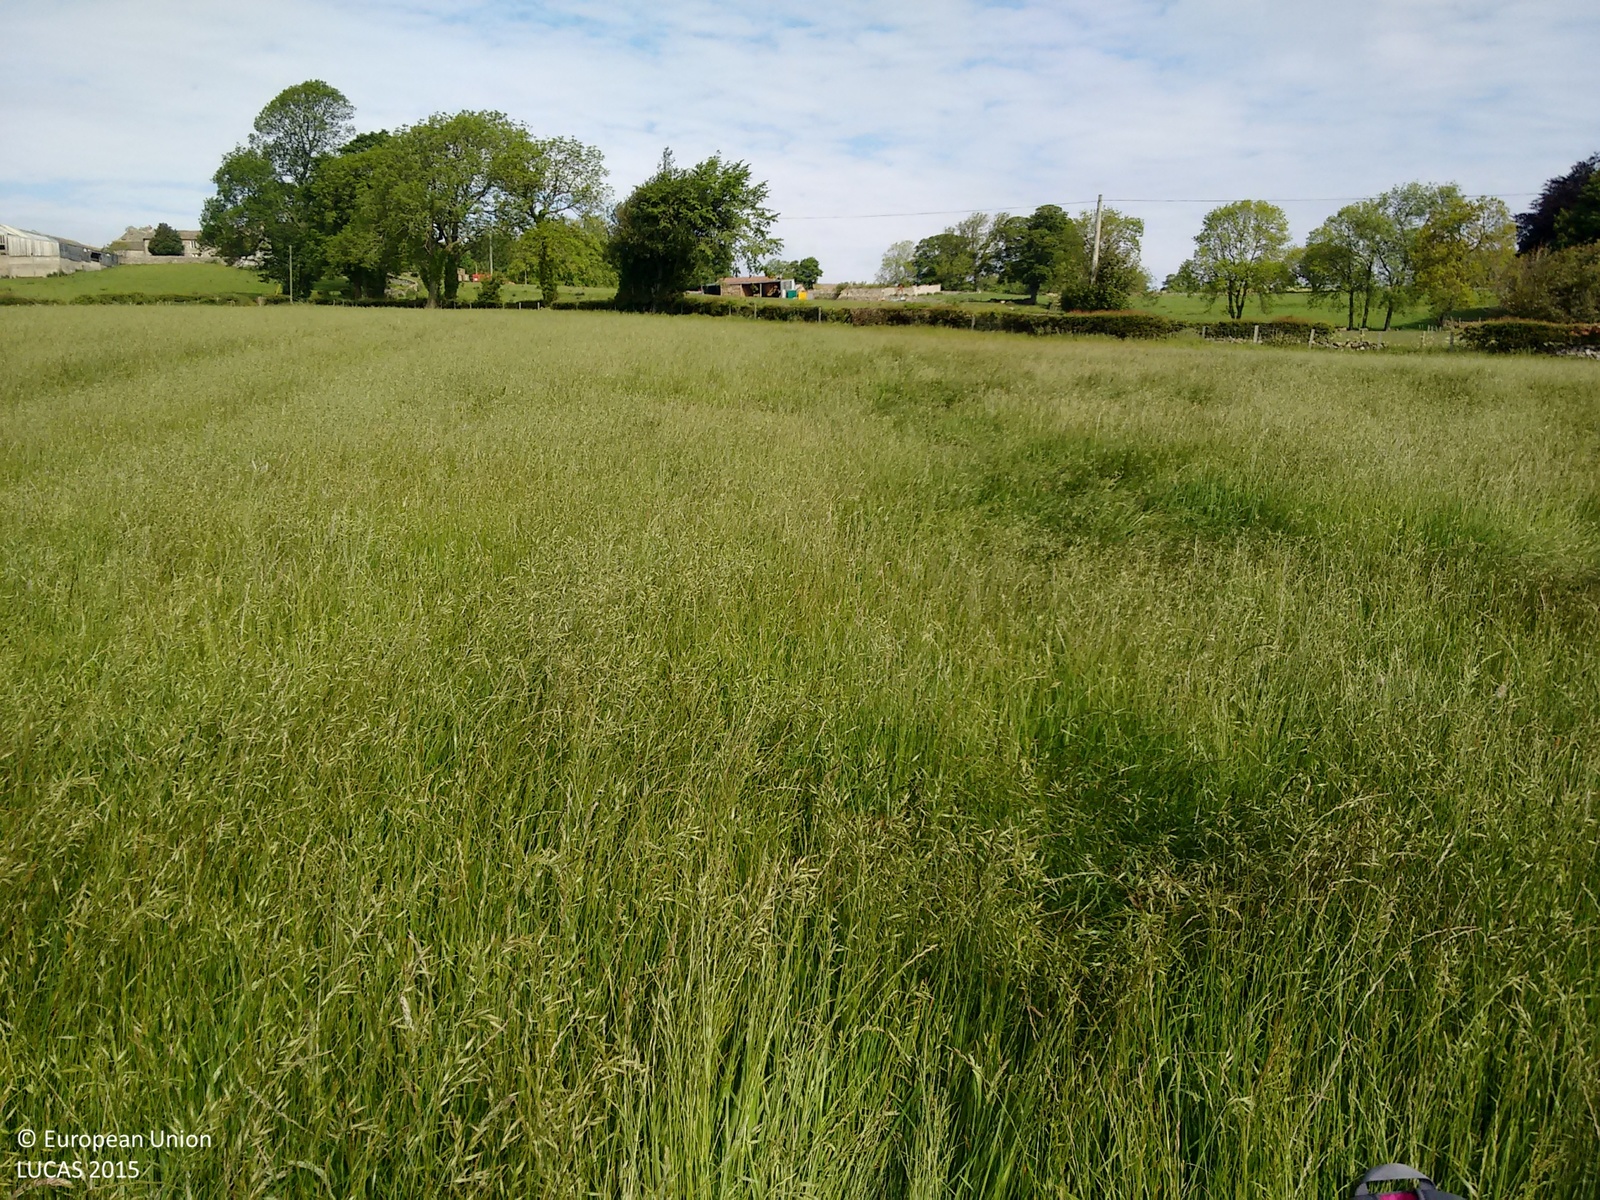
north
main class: Grassland
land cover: Grassland without tree/shrub cover
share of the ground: > 75 %
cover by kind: herbaceous plants 100 %
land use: Agriculture (excluding fallow land and kitchen gardens)
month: June
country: GB
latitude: 54.2710
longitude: -1.8626
